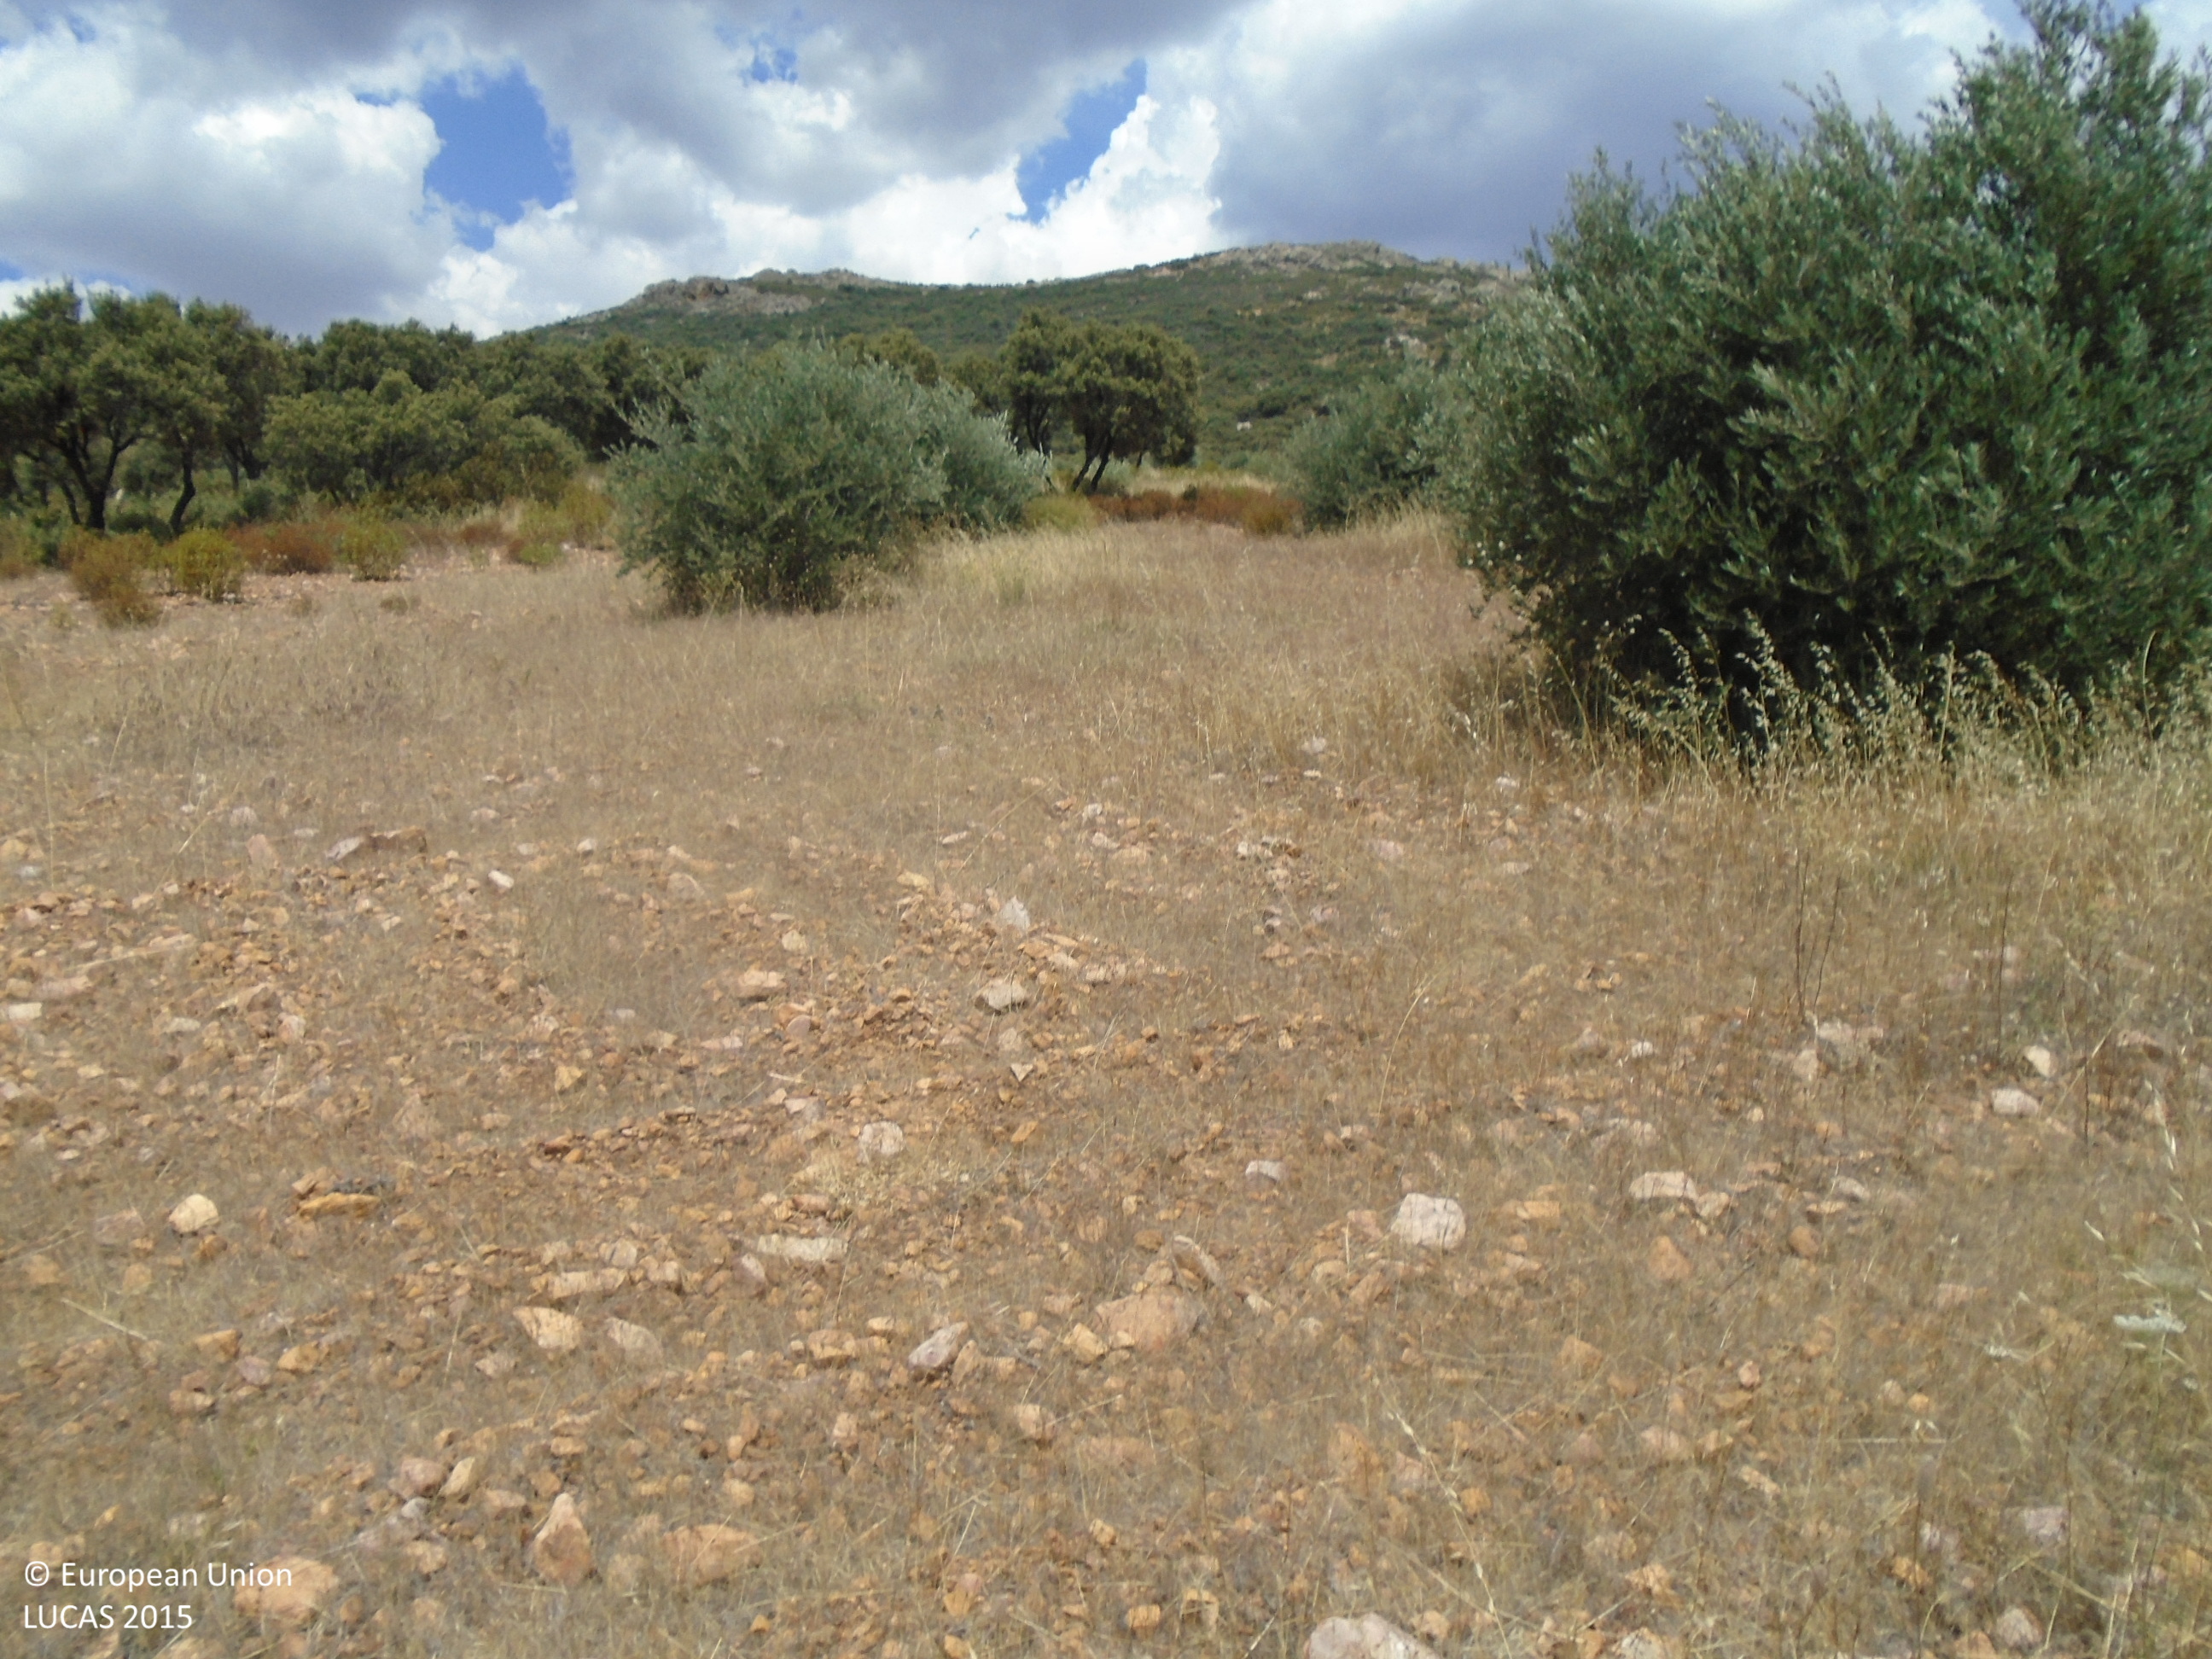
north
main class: Cropland
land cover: Olive groves
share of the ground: 10 - 25 %
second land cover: Spontaneously vegetated surfaces
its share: > 75 %
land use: Agriculture (excluding fallow land and kitchen gardens)
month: June
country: ES
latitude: 39.2374
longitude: -3.6335
